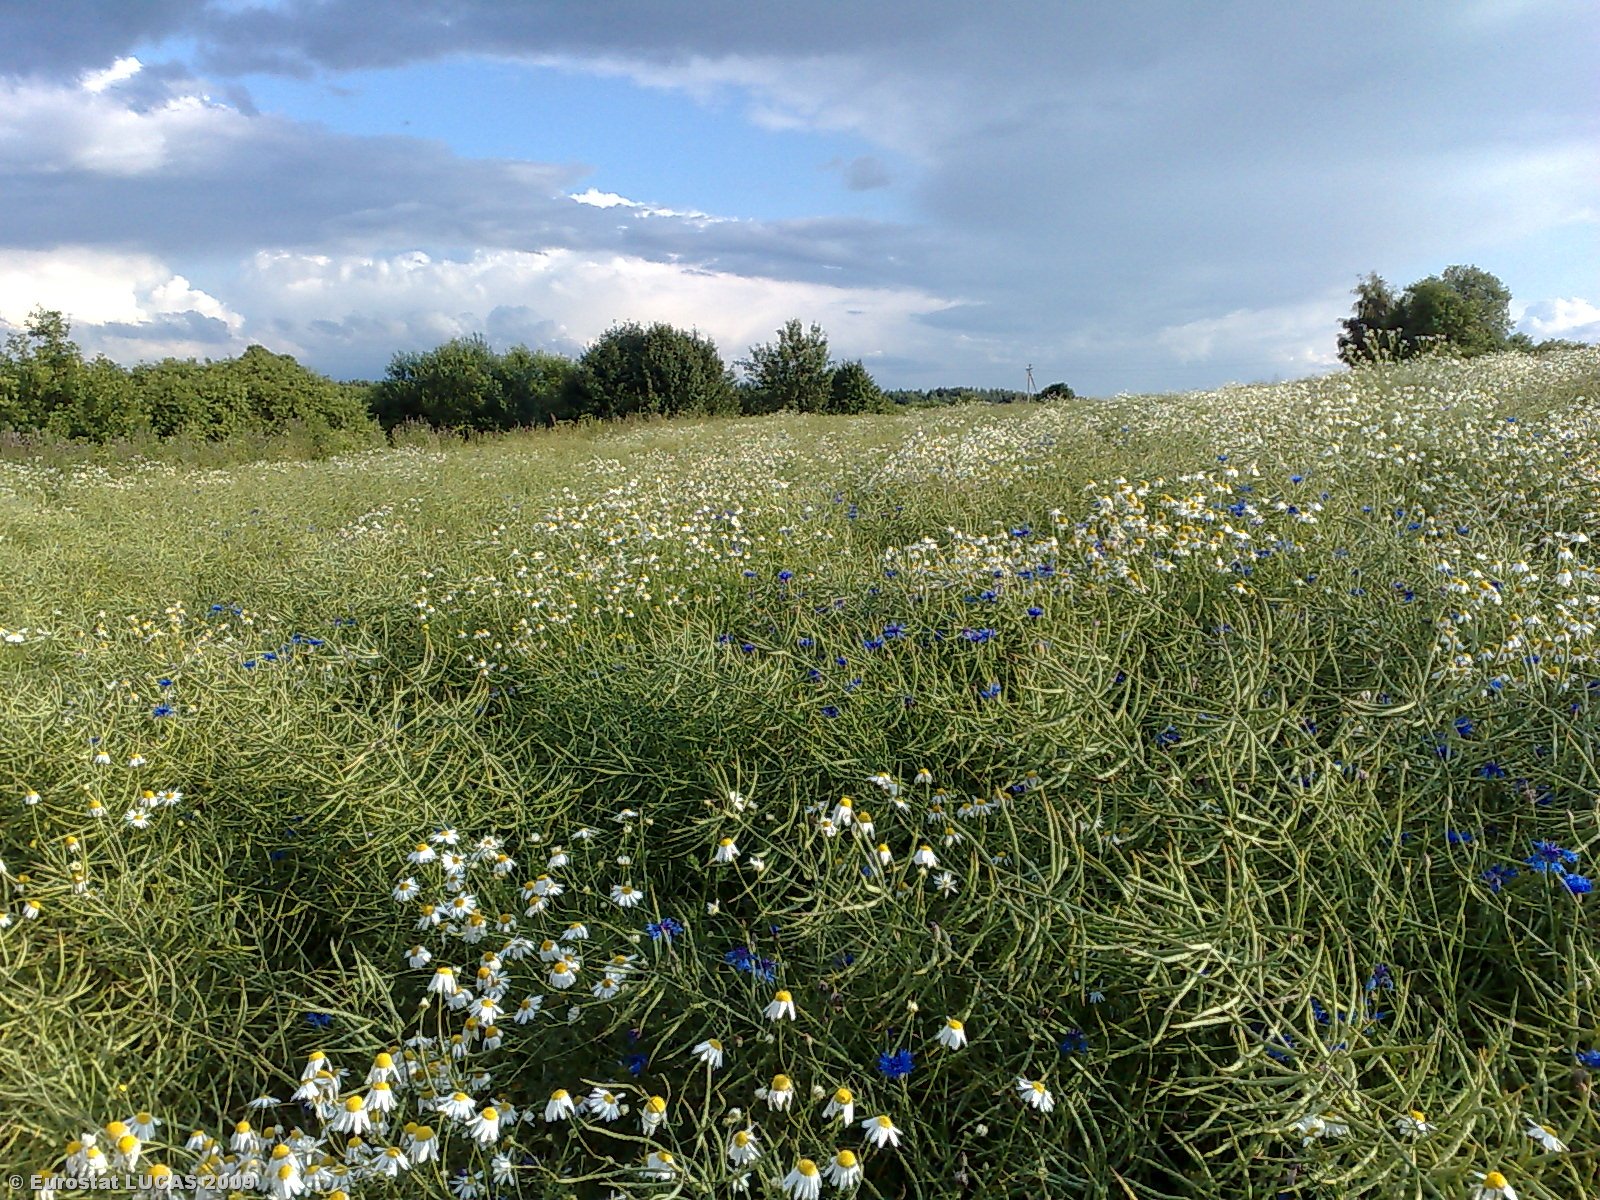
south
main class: Cropland
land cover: Rape and turnip rape
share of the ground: > 75 %
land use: Agriculture (excluding fallow land and kitchen gardens)
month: July
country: LT
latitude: 55.6500
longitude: 22.8267
